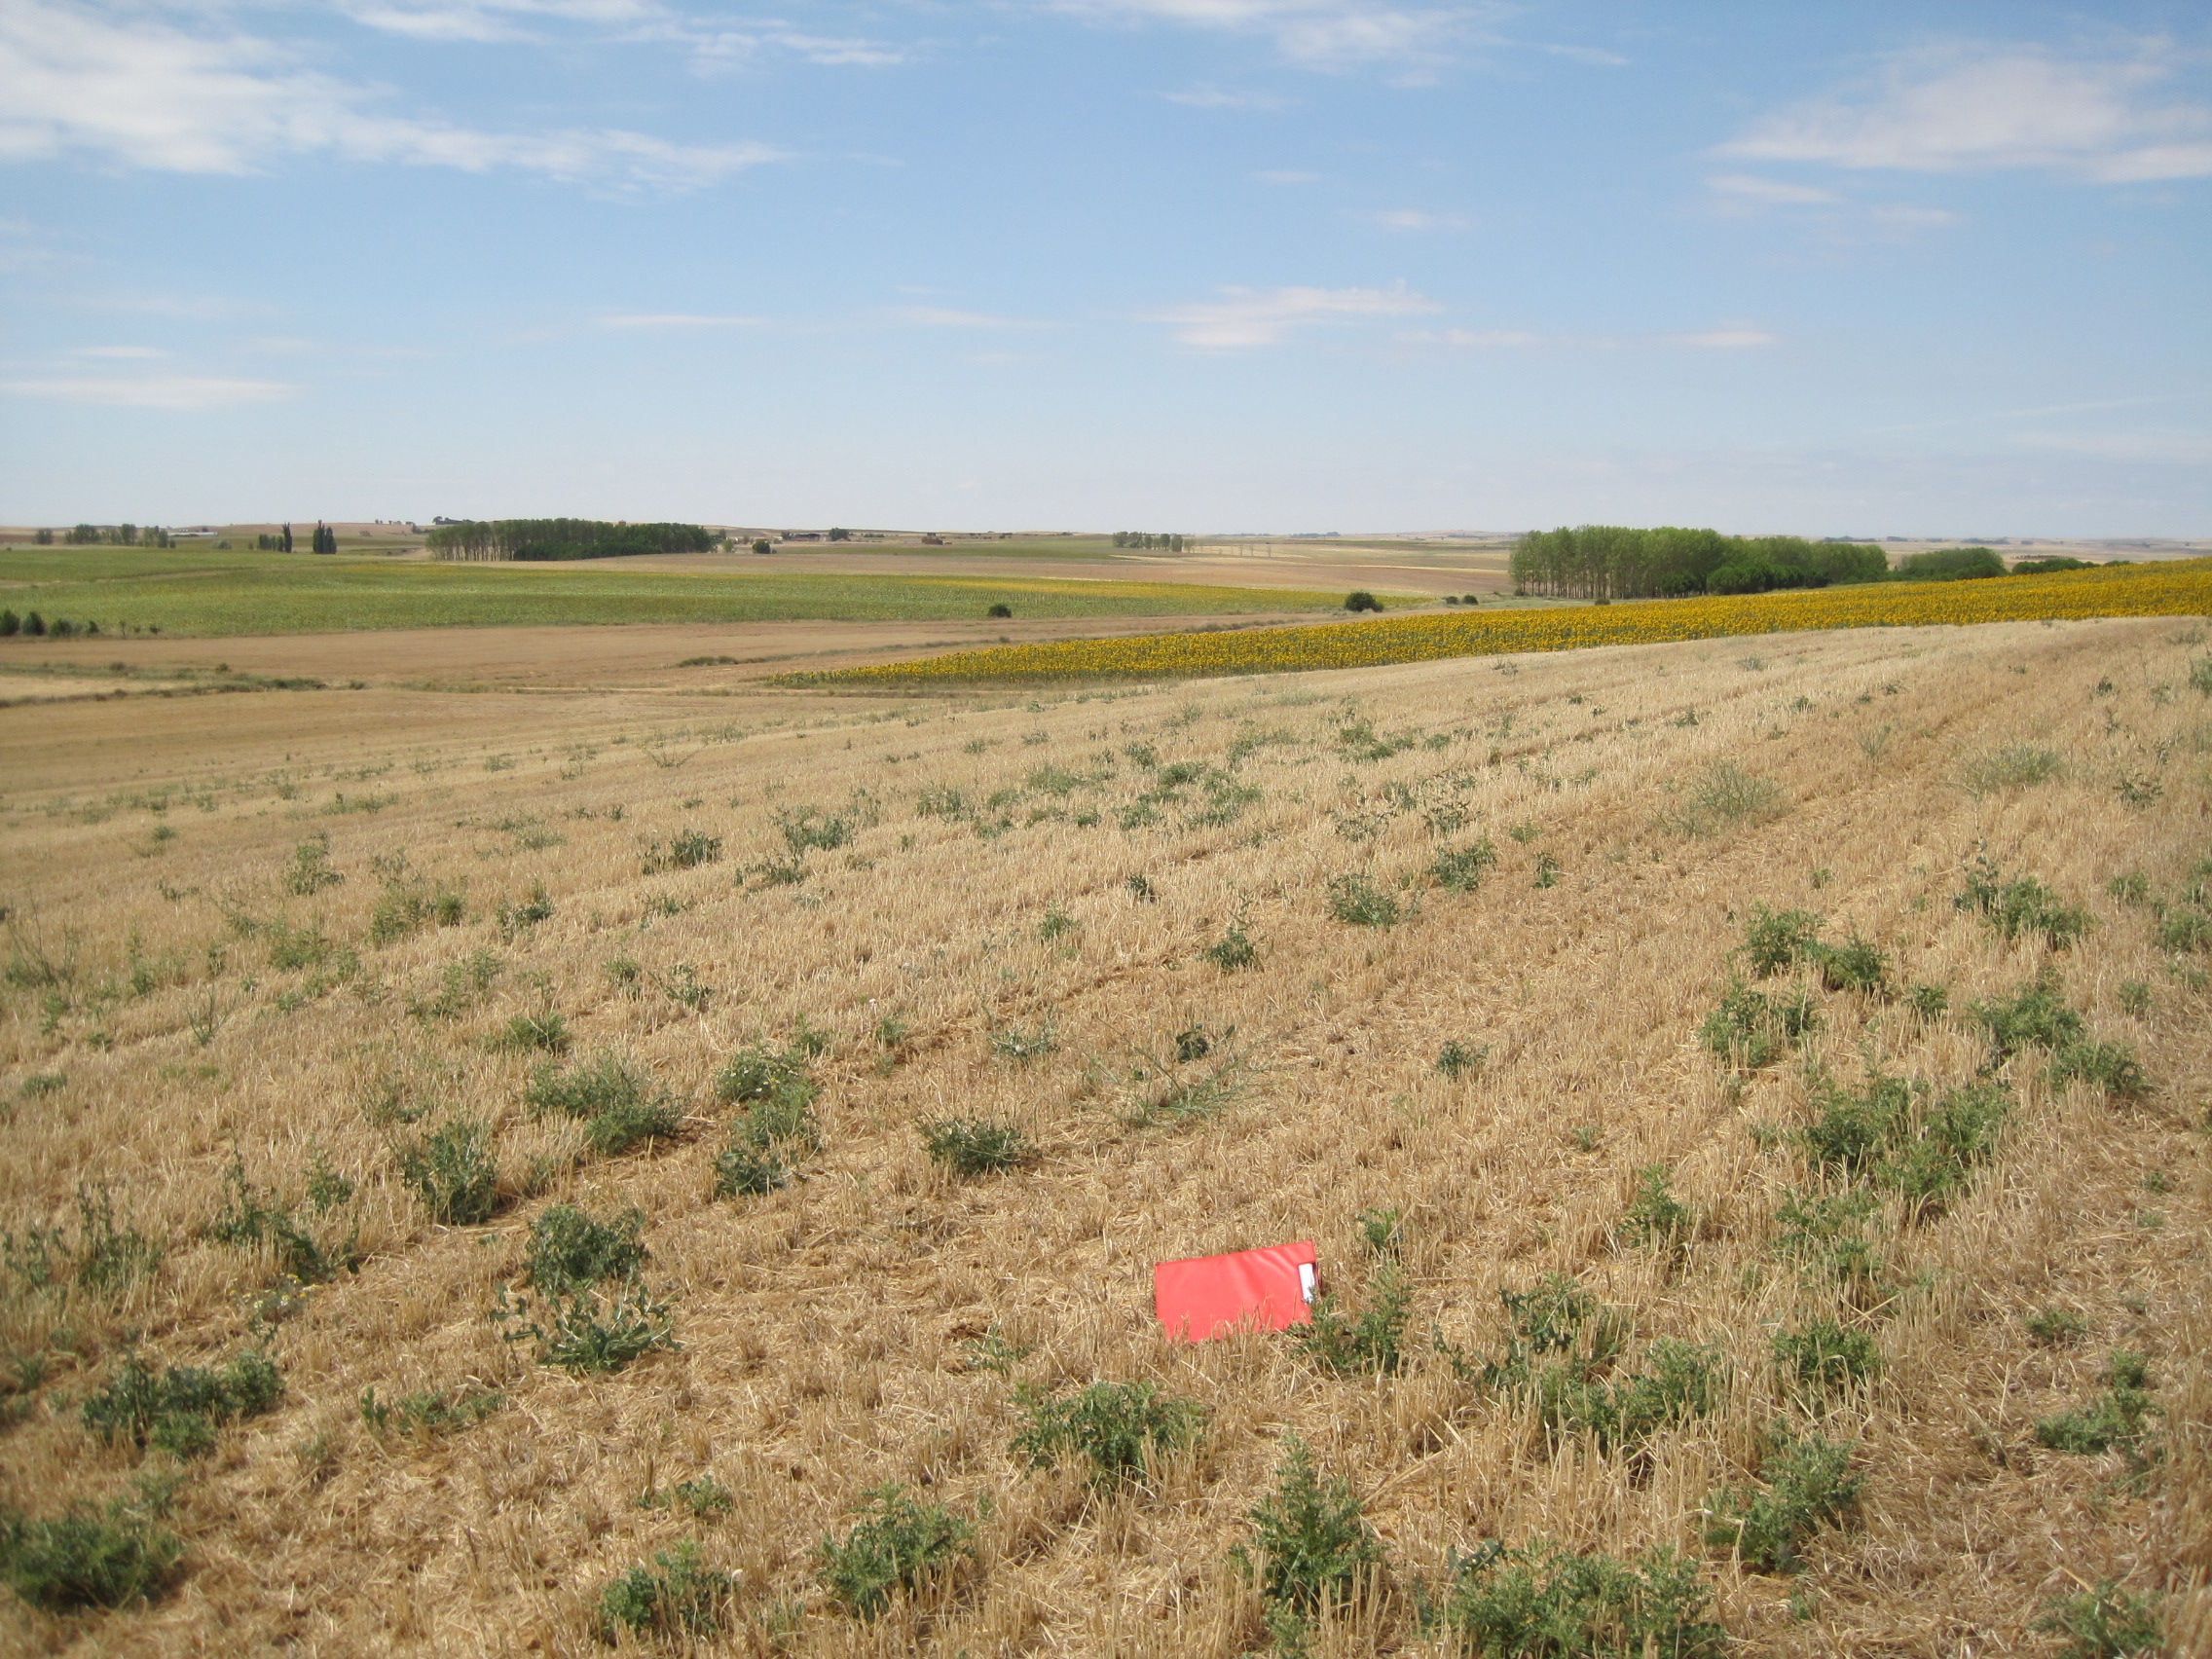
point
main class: Cropland
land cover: Barley
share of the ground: < 10 %
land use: Agriculture (excluding fallow land and kitchen gardens)
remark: Harvested field
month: July
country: ES
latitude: 42.0285
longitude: -5.2169
